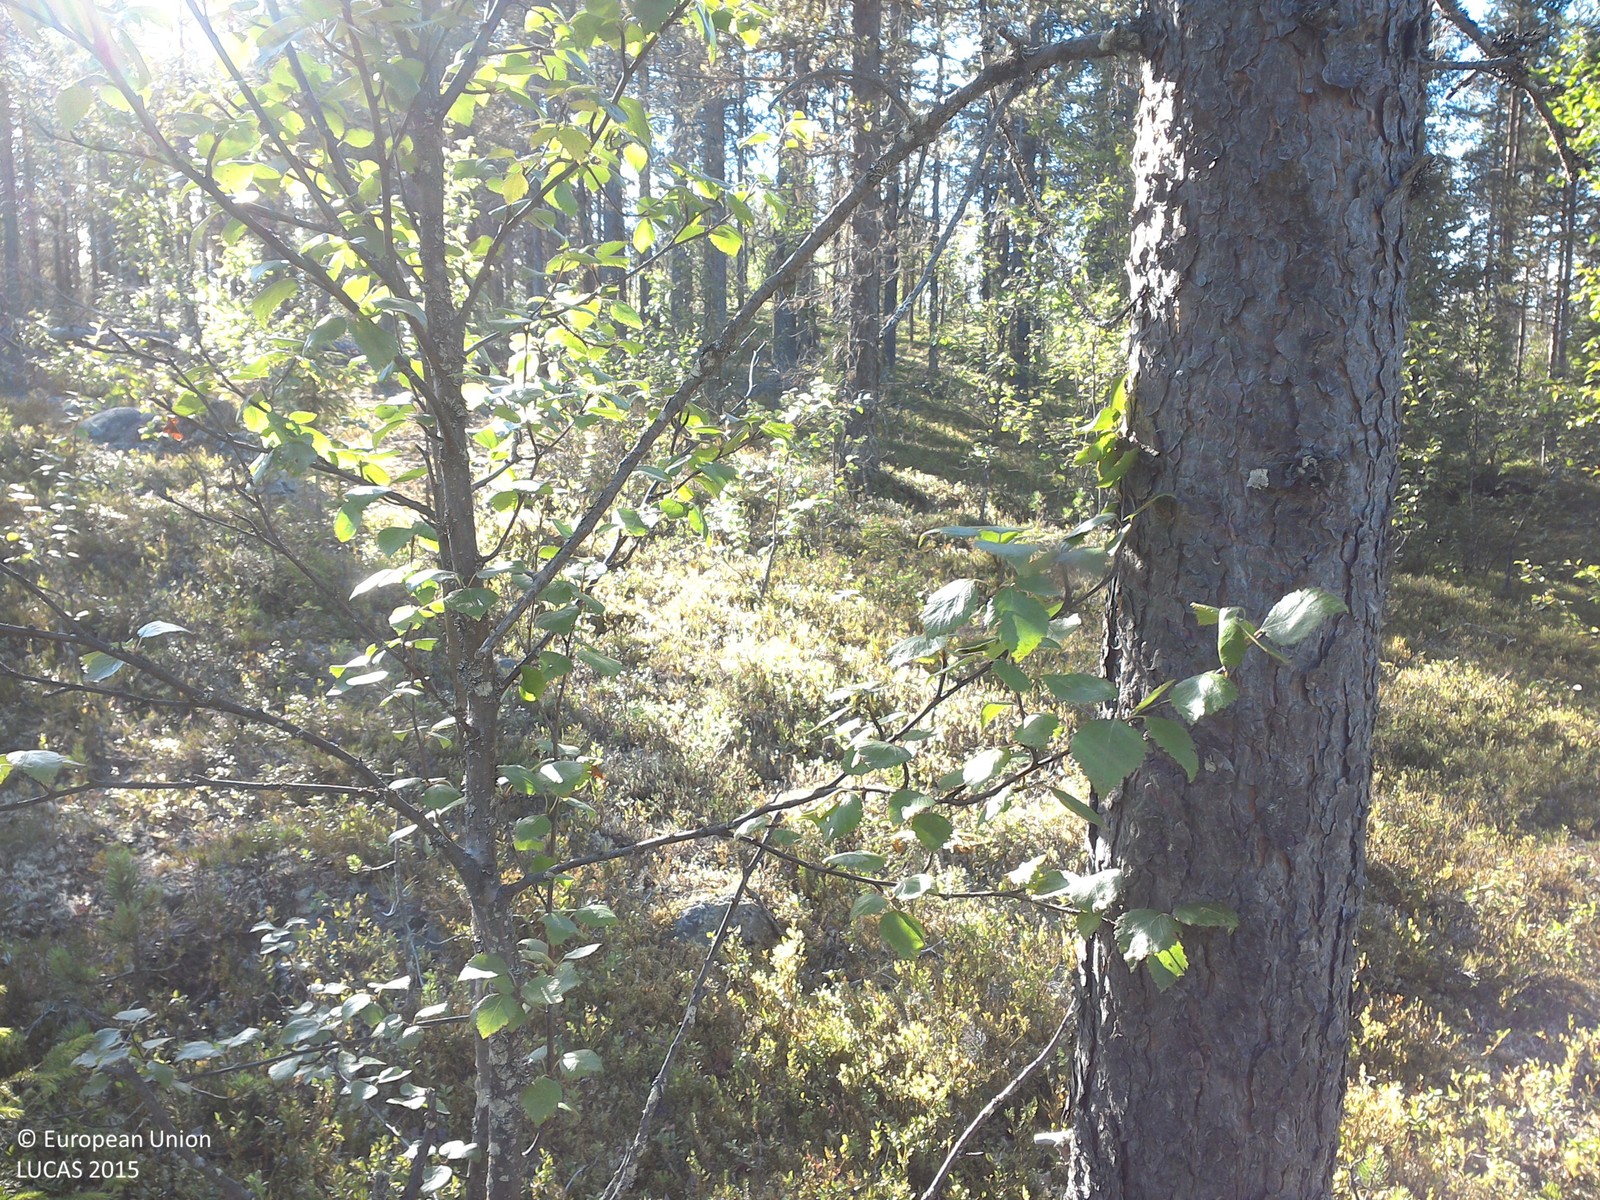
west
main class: Woodland
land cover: Pine dominated mixed woodland
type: boreal forest
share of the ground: 25 - 50 %
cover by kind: shrubs 50 %, coniferous forest trees 20 %, lichens and mosses 20 %, broadleaved forest trees 10 %
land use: Forestry
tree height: > 5 m
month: August
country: SE
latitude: 67.3901
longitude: 21.4419
